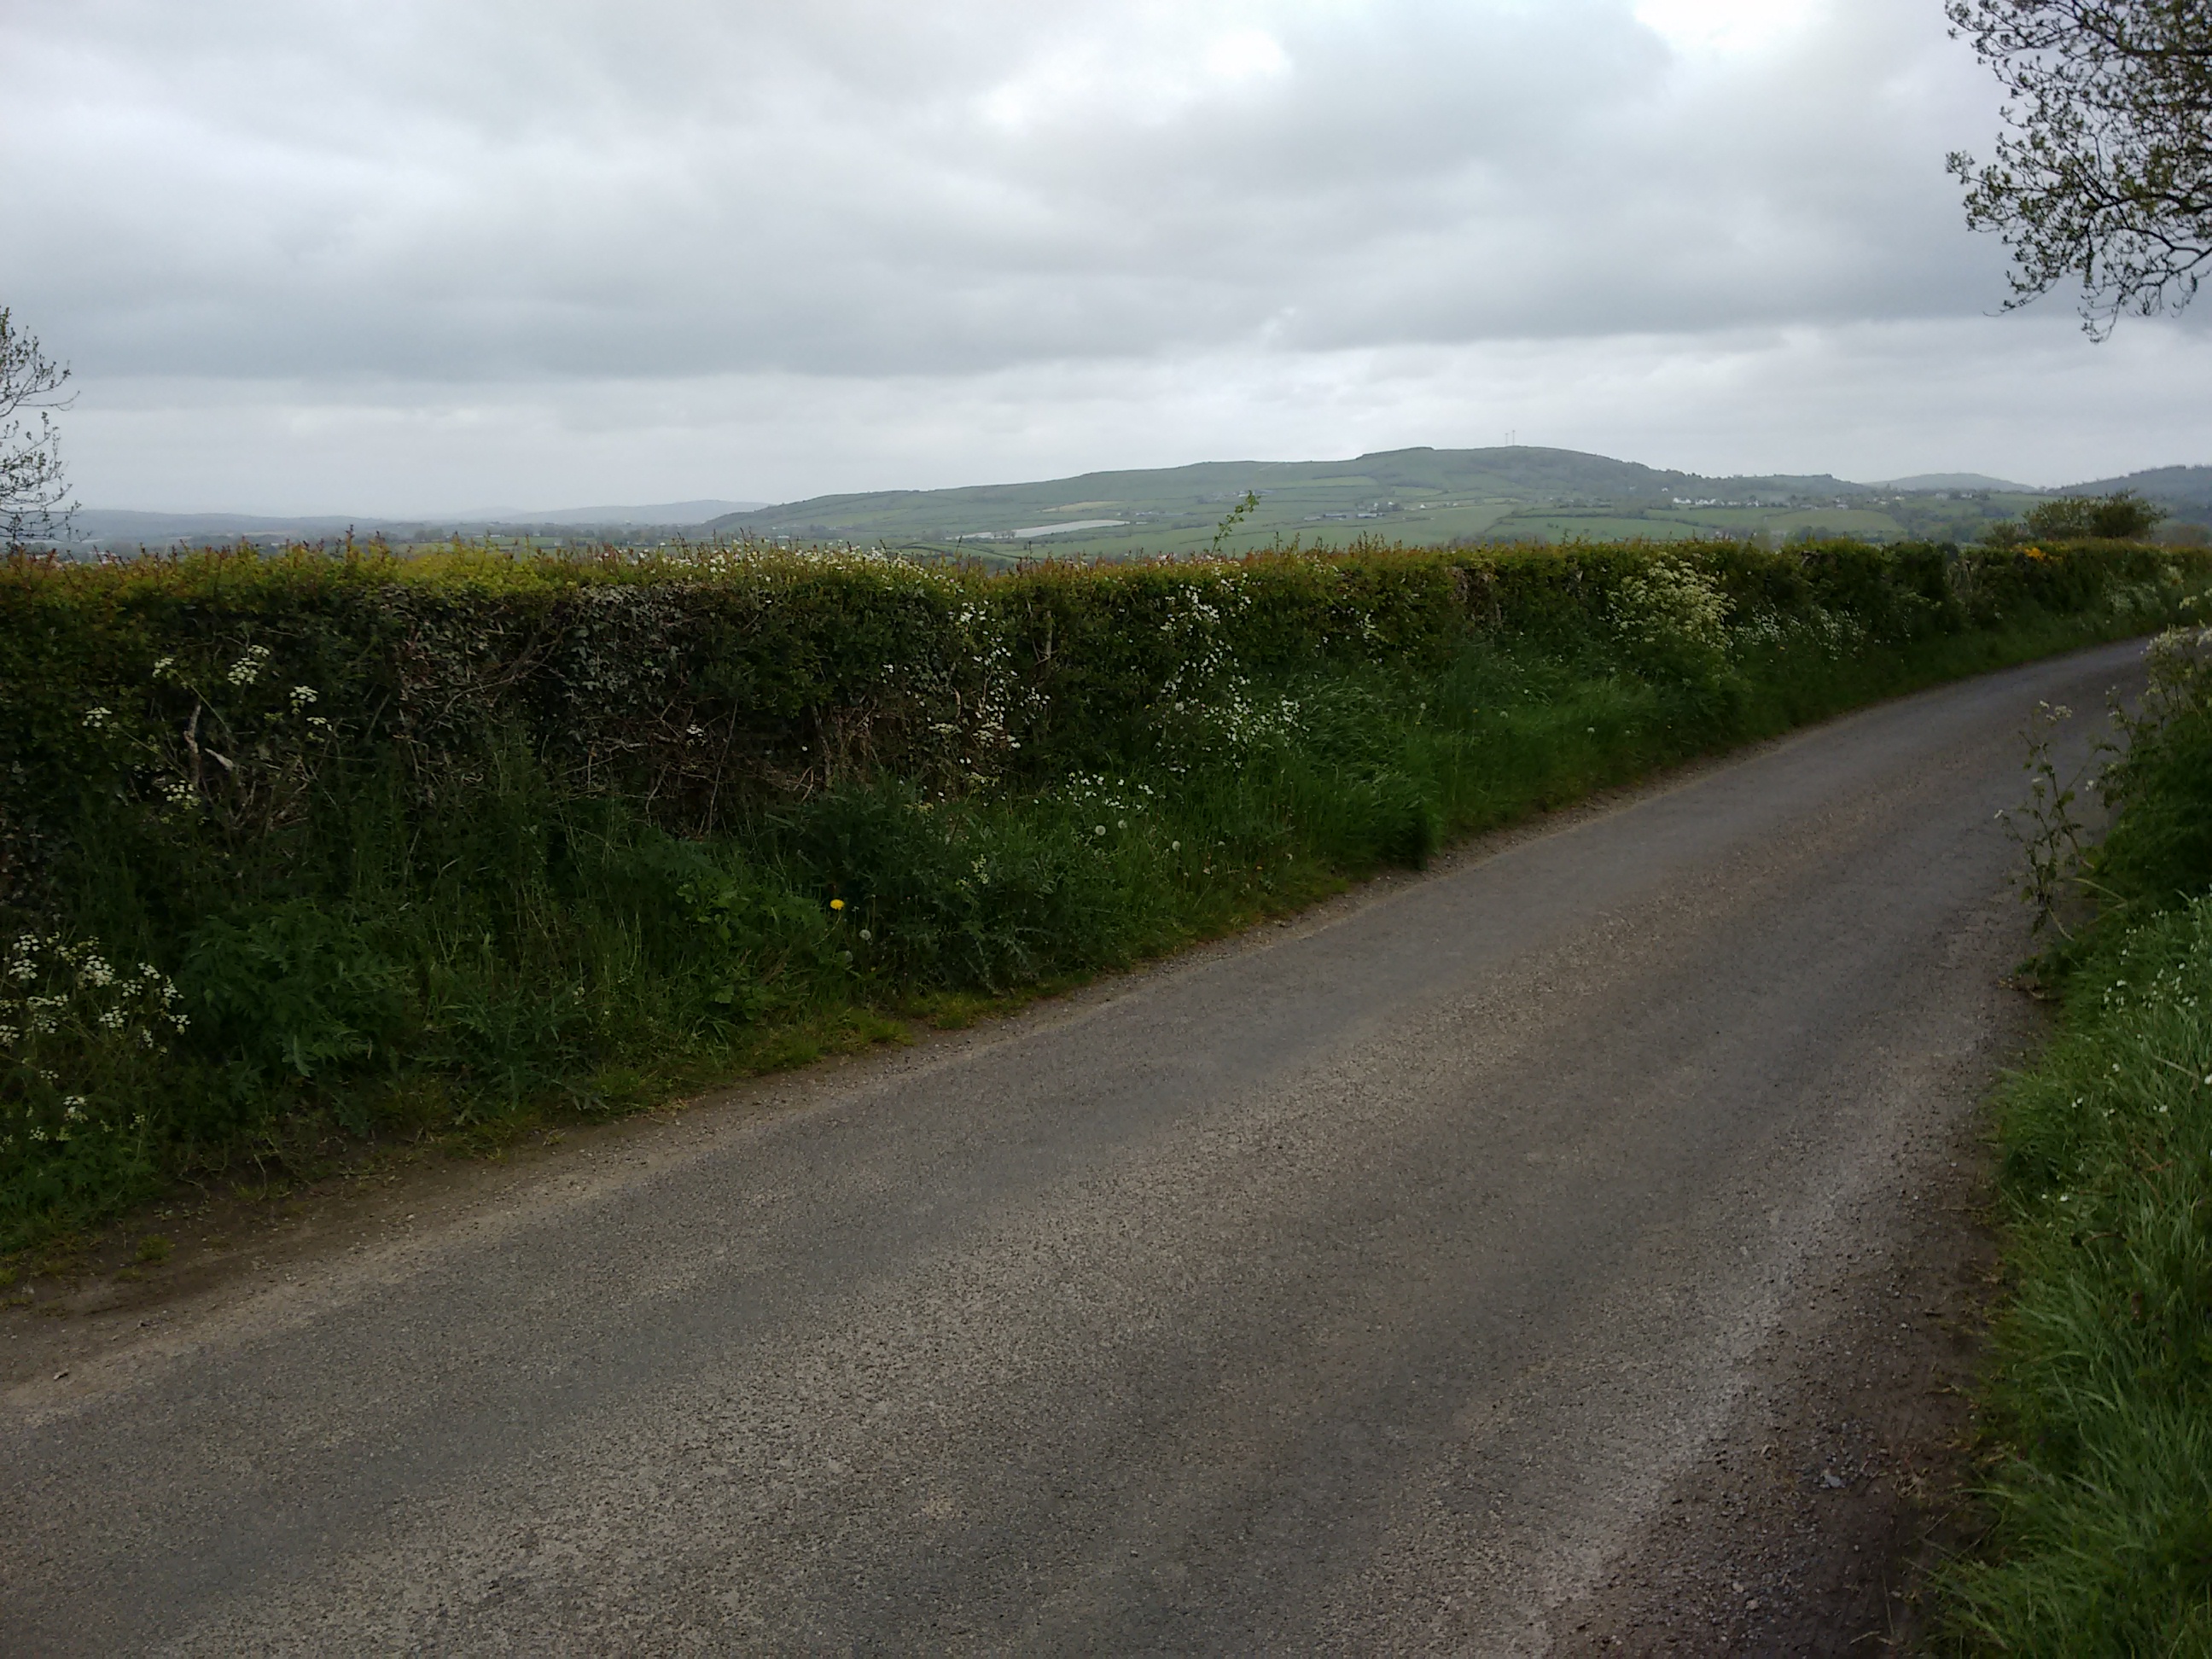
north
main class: Grassland
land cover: Grassland without tree/shrub cover
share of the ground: > 75 %
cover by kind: herbaceous plants 100 %
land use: Agriculture (excluding fallow land and kitchen gardens)
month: May
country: GB
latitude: 54.8735
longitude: -7.4028
